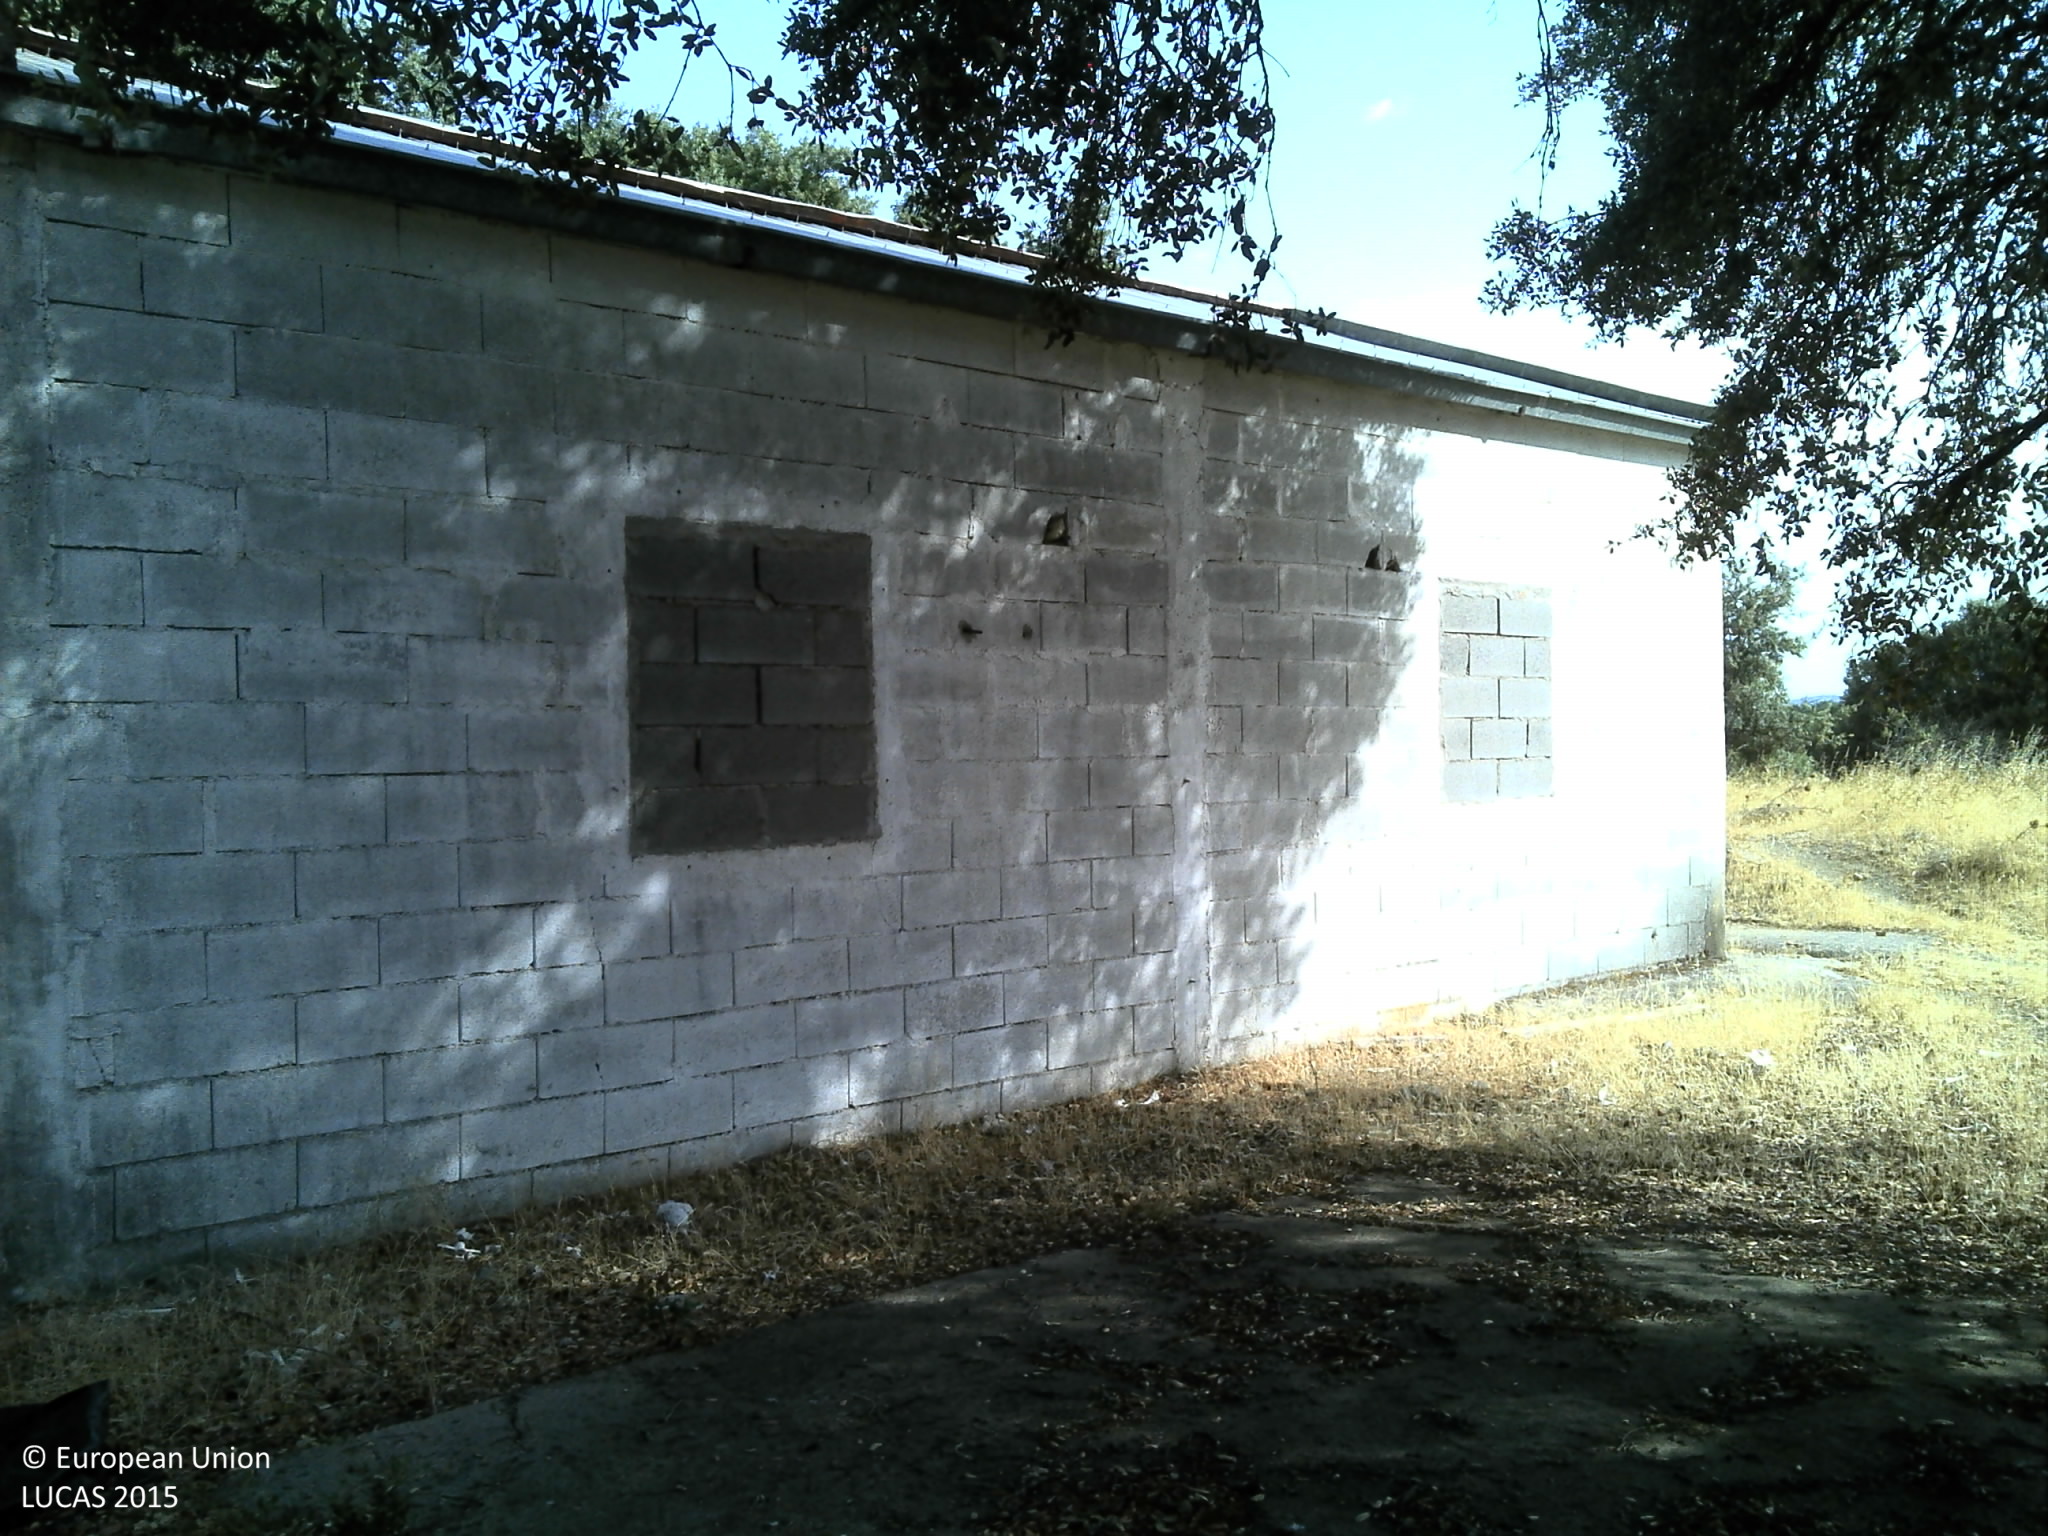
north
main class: Woodland
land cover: Broadleaved woodland
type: broadleaved evergreen forest
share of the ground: 10 - 25 %
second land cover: Grassland without tree/shrub cover
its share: 10 - 25 %
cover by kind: unconsolidated bare surface 80 %, broadleaved forest trees 10 %, herbaceous plants 10 %
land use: Forestry
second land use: Agriculture (excluding fallow land and kitchen gardens)
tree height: > 5 m
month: July
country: PT
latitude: 38.7197
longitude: -7.7861
